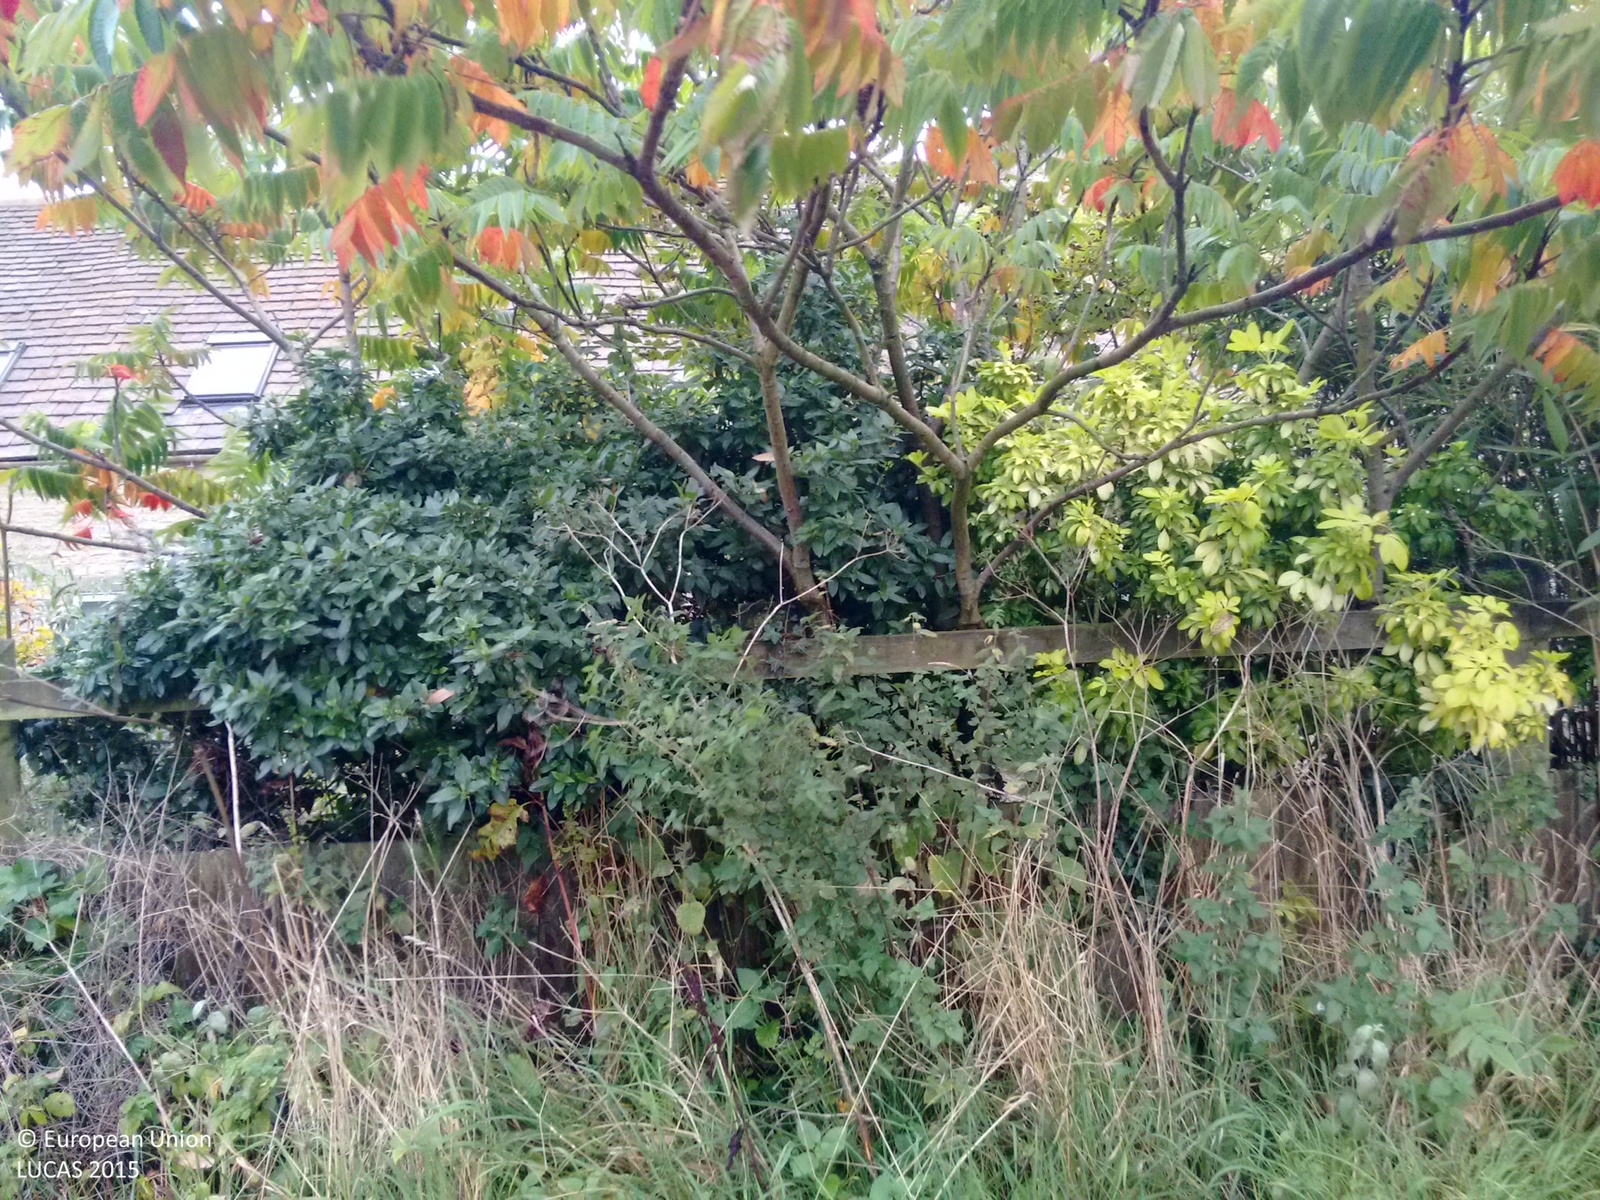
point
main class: Grassland
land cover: Grassland with sparse tree/shrub cover
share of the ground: > 75 %
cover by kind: herbaceous plants 90 %, broadleaved forest trees 5 %, shrubs 5 %
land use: Residential
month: October
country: GB
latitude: 51.7677
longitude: -1.9842
